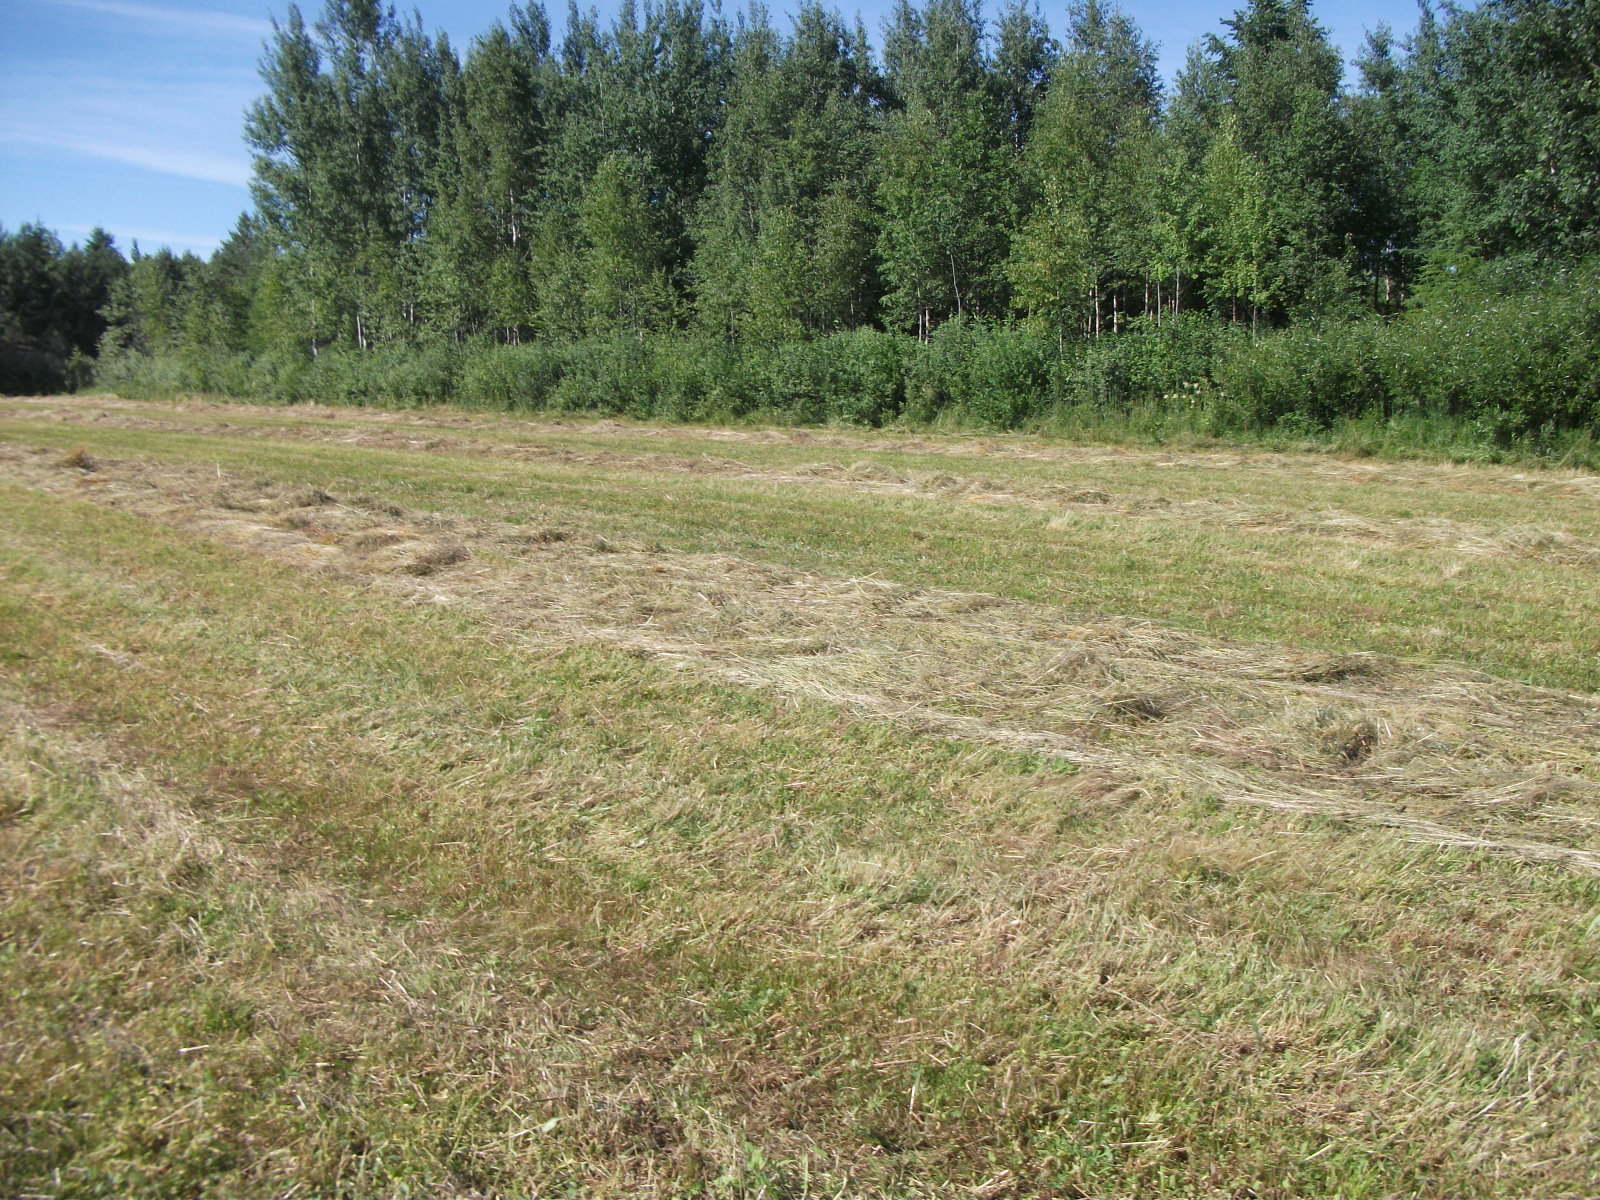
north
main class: Grassland
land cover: Grassland without tree/shrub cover
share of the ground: > 75 %
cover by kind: herbaceous plants 100 %
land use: Agriculture (excluding fallow land and kitchen gardens)
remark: Harvested field
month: July
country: LV
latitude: 56.7477
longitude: 26.3471
